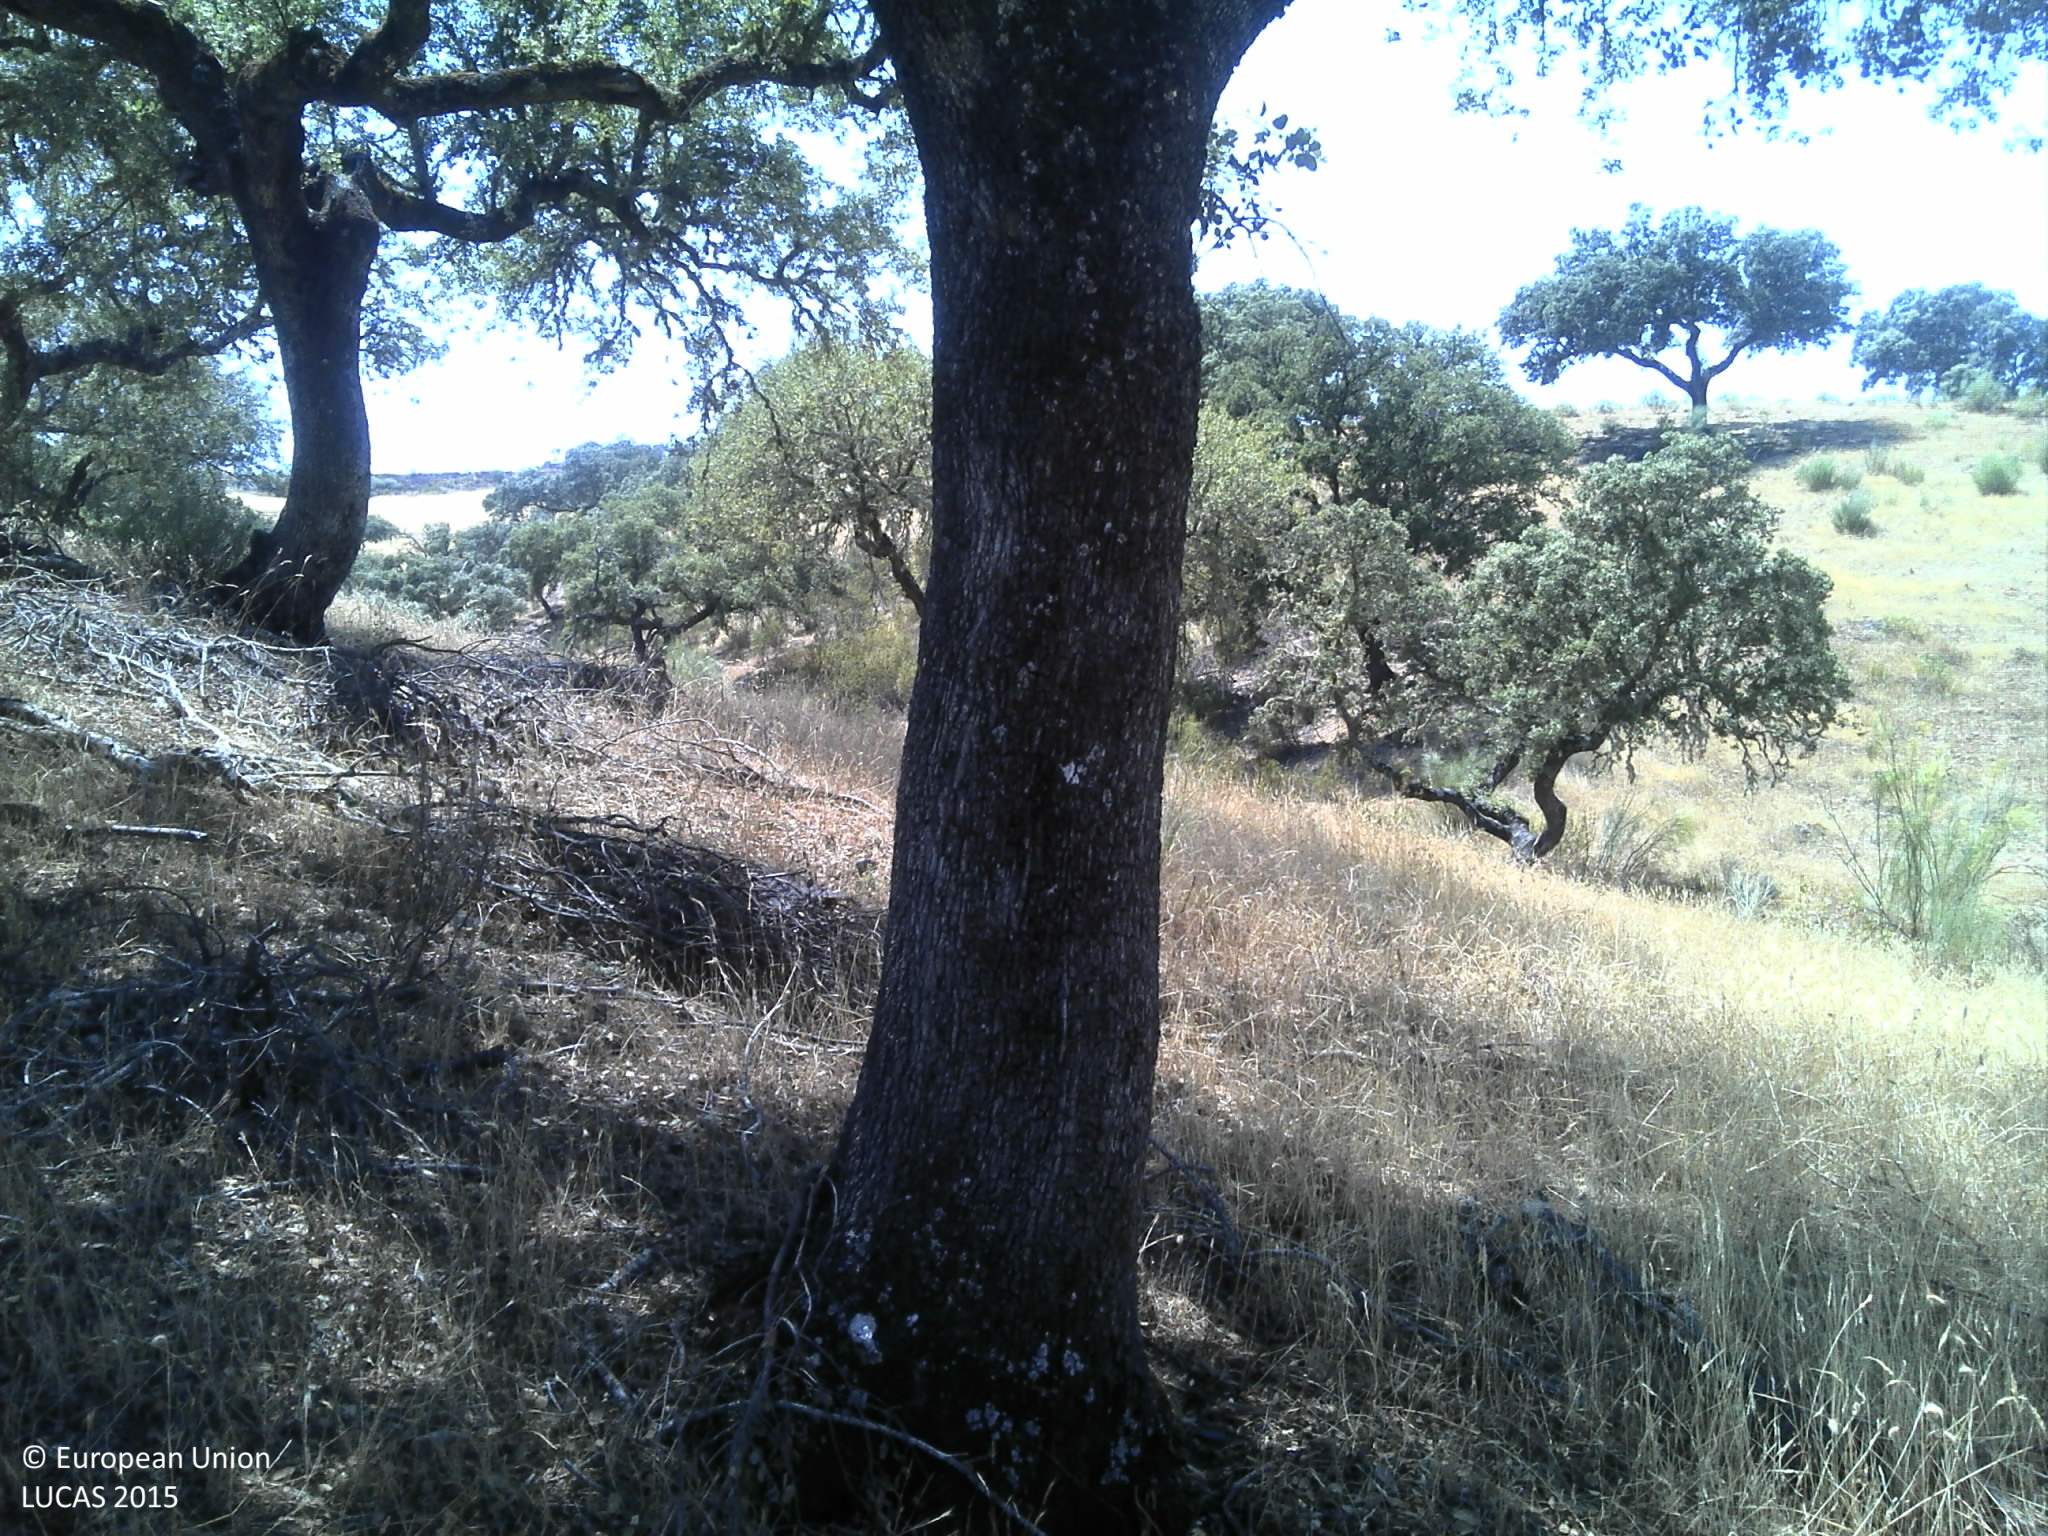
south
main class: Woodland
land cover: Broadleaved woodland
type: broadleaved evergreen forest
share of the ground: 25 - 50 %
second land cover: Grassland without tree/shrub cover
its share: 50 - 75 %
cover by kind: herbaceous plants 60 %, broadleaved forest trees 30 %, shrubs 5 %, unconsolidated bare surface 5 %
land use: Forestry
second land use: Agriculture (excluding fallow land and kitchen gardens)
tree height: > 5 m
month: June
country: PT
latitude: 39.7439
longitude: -7.2344
